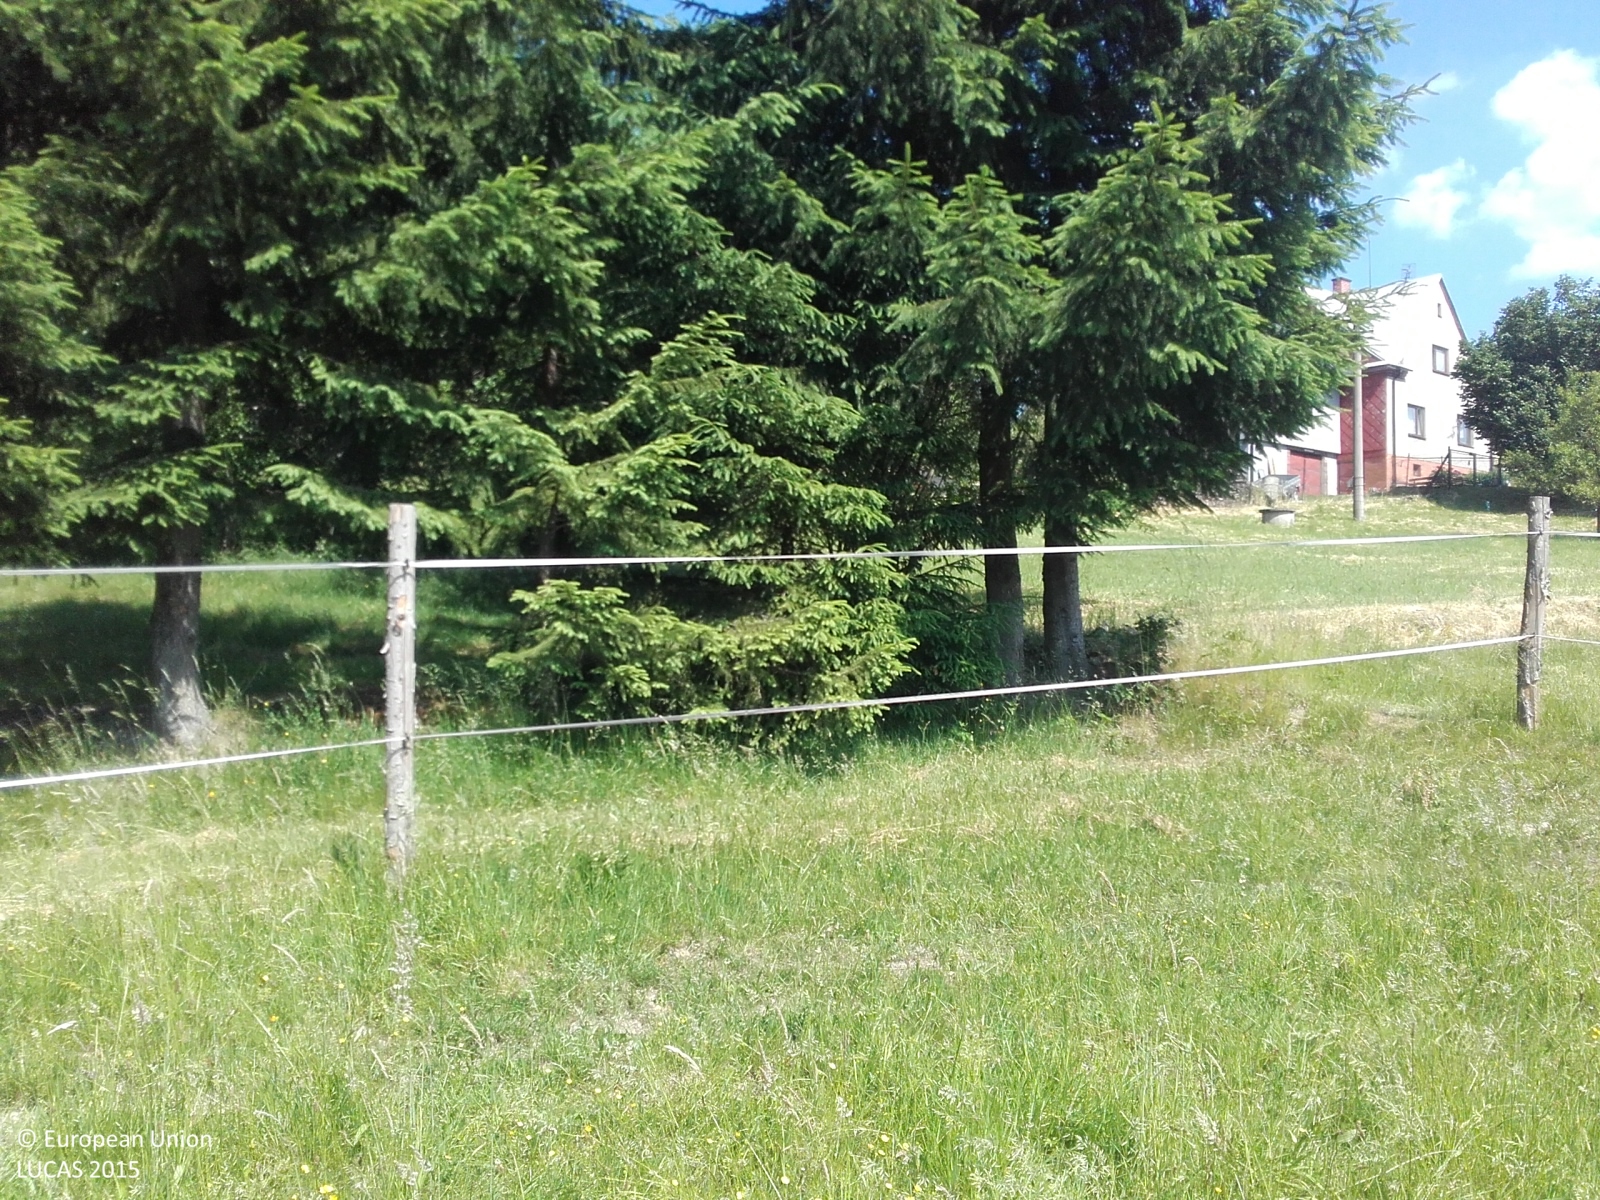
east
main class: Grassland
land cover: Grassland without tree/shrub cover
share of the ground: > 75 %
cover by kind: herbaceous plants 100 %
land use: Agriculture (excluding fallow land and kitchen gardens)
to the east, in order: Grassland without tree/shrub cover; Fences; Grassland without tree/shrub cover; Lines of trees; Grassland without tree/shrub cover; Electric lines; Grassland without tree/shrub cover; Fences; Grassland with sparse tree/shrub cover; Fences; Broadleaved woodland; Grassland with sparse tree/shrub cover; Artificial constructions in urban areas; Grassland without tree/shrub cover
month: June
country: CZ
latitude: 49.5919
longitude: 18.7776
